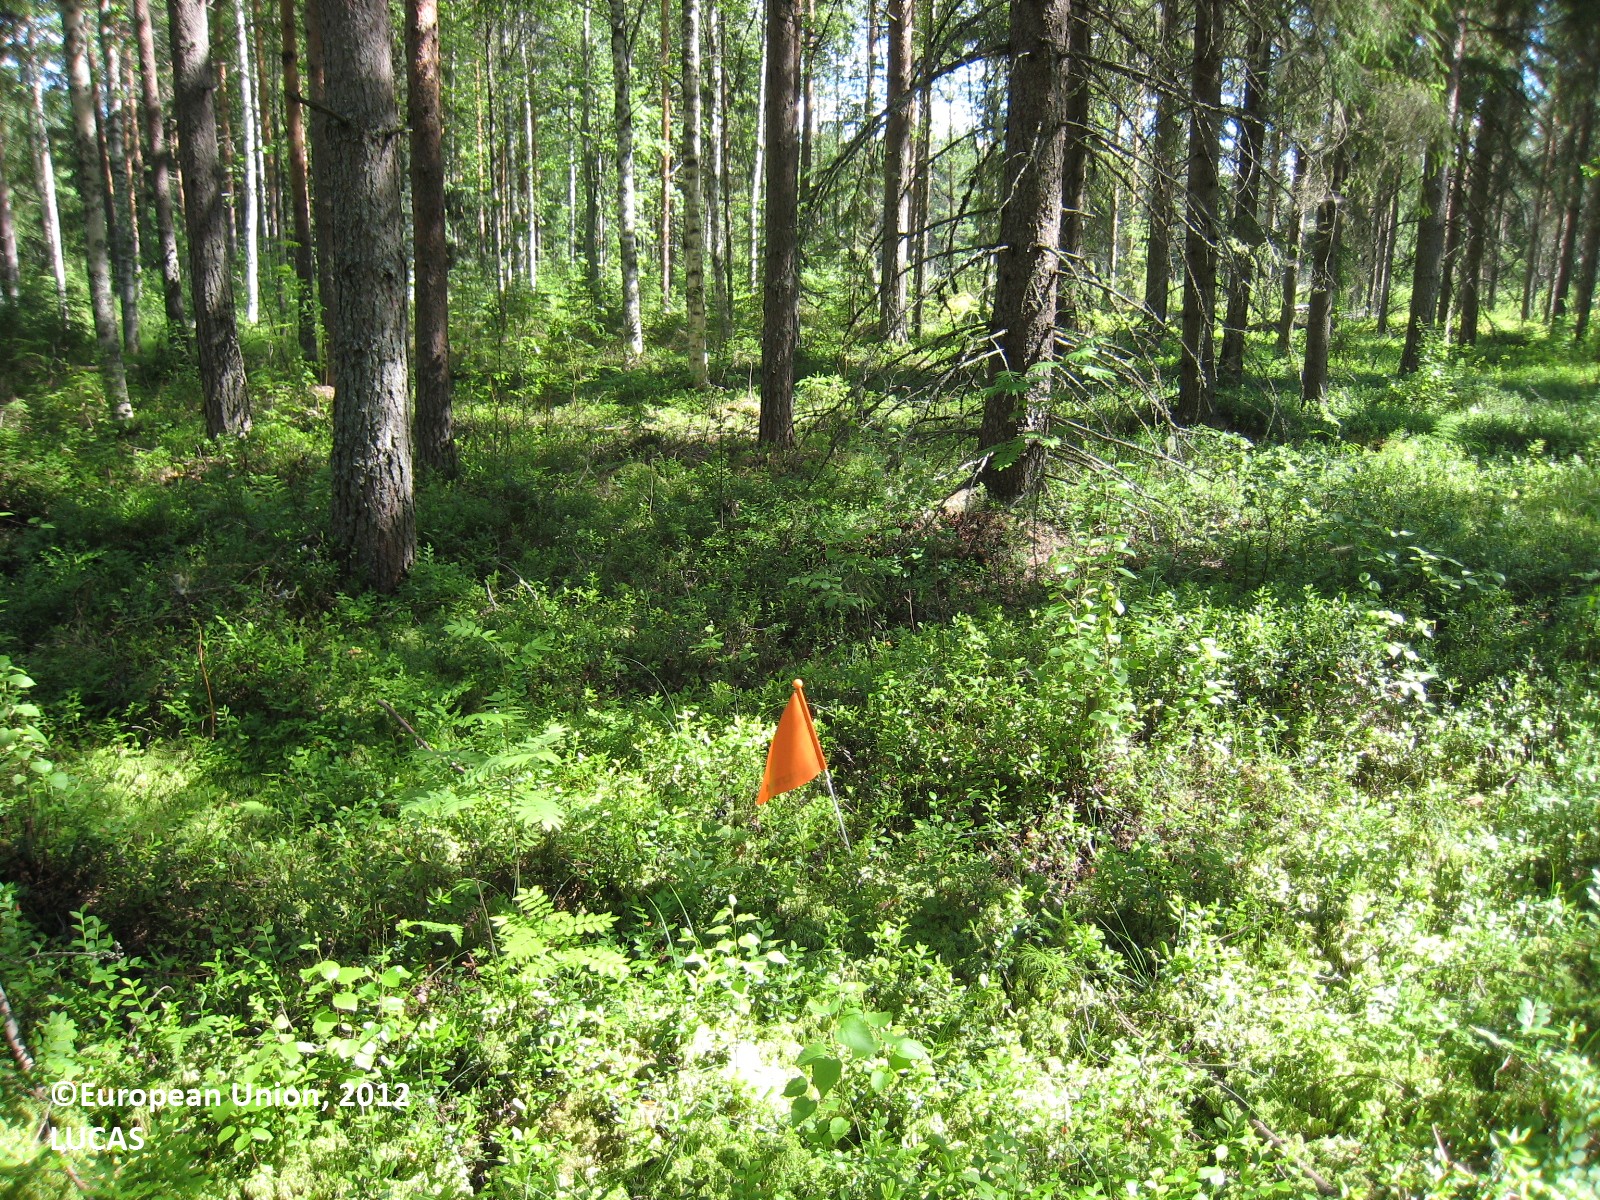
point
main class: Woodland
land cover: Other mixed woodland
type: boreal forest
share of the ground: 50 - 75 %
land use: Forestry
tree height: > 5 m
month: July
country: FI
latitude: 63.2240
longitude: 25.8507
